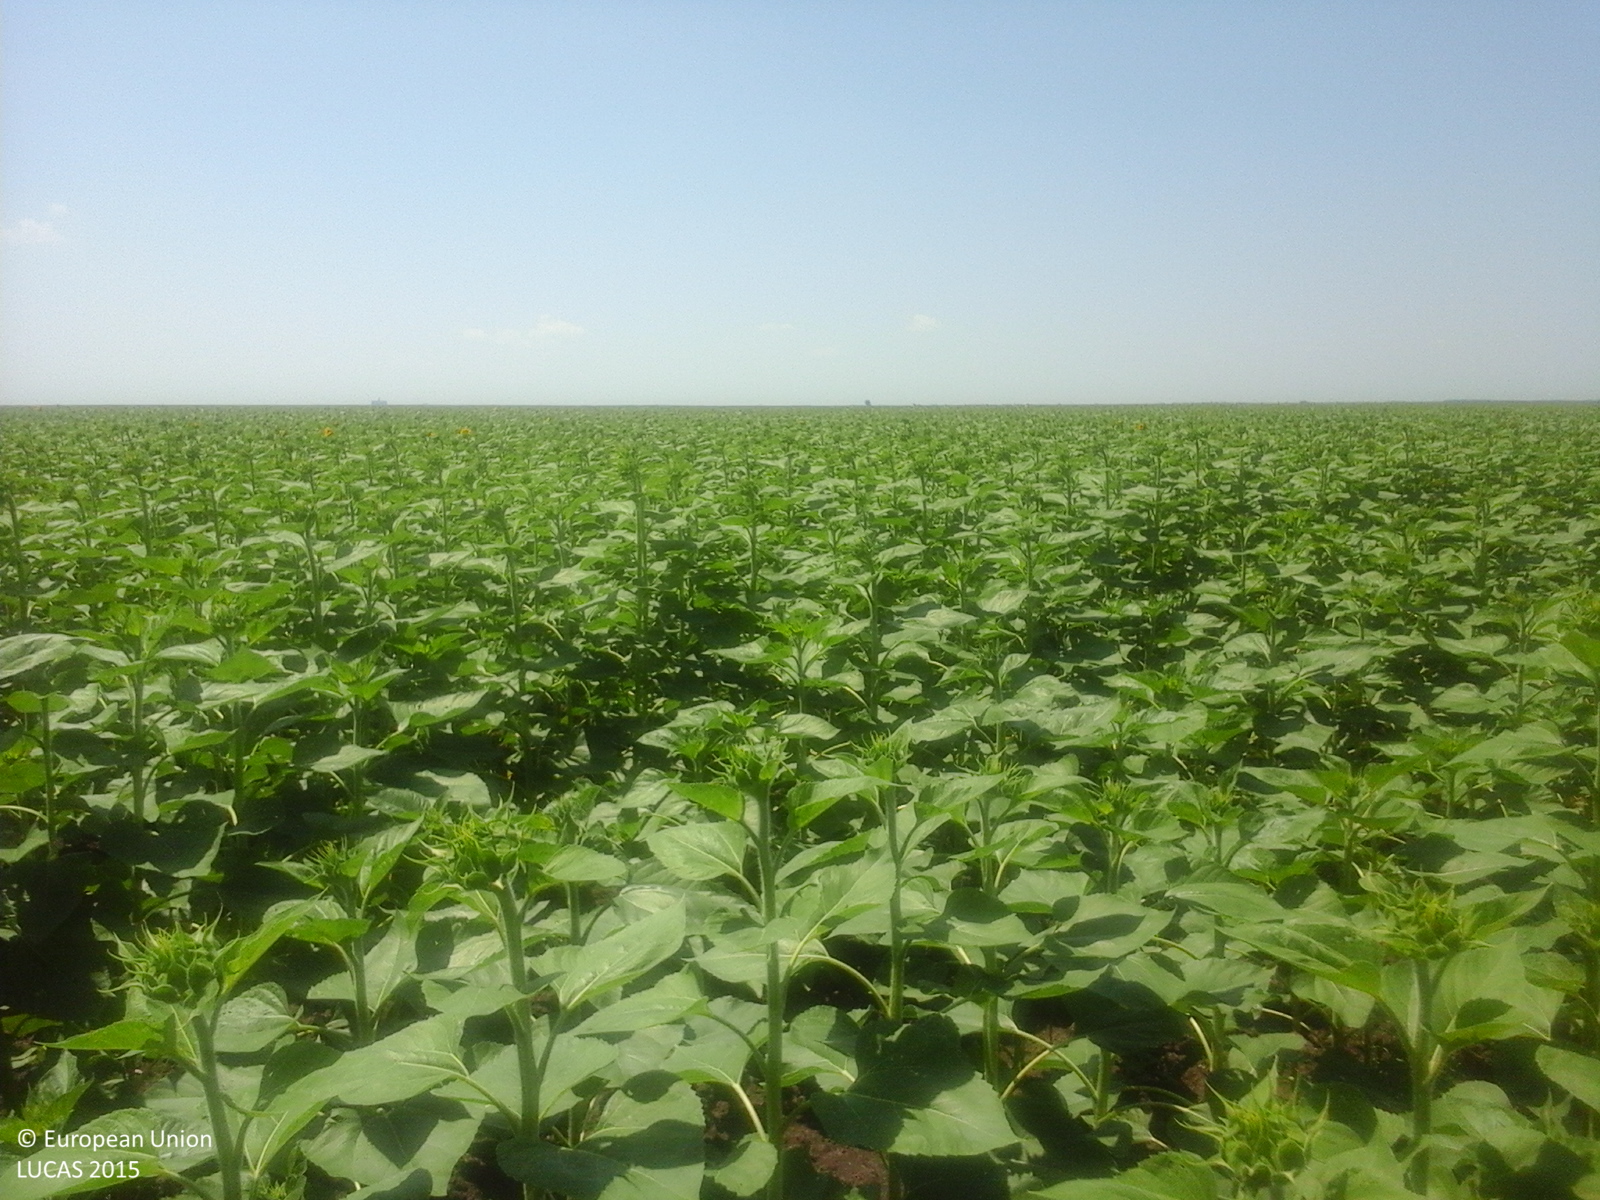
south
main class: Cropland
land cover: Sunflower
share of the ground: > 75 %
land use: Agriculture (excluding fallow land and kitchen gardens)
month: July
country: RO
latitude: 44.1943
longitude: 24.6984
